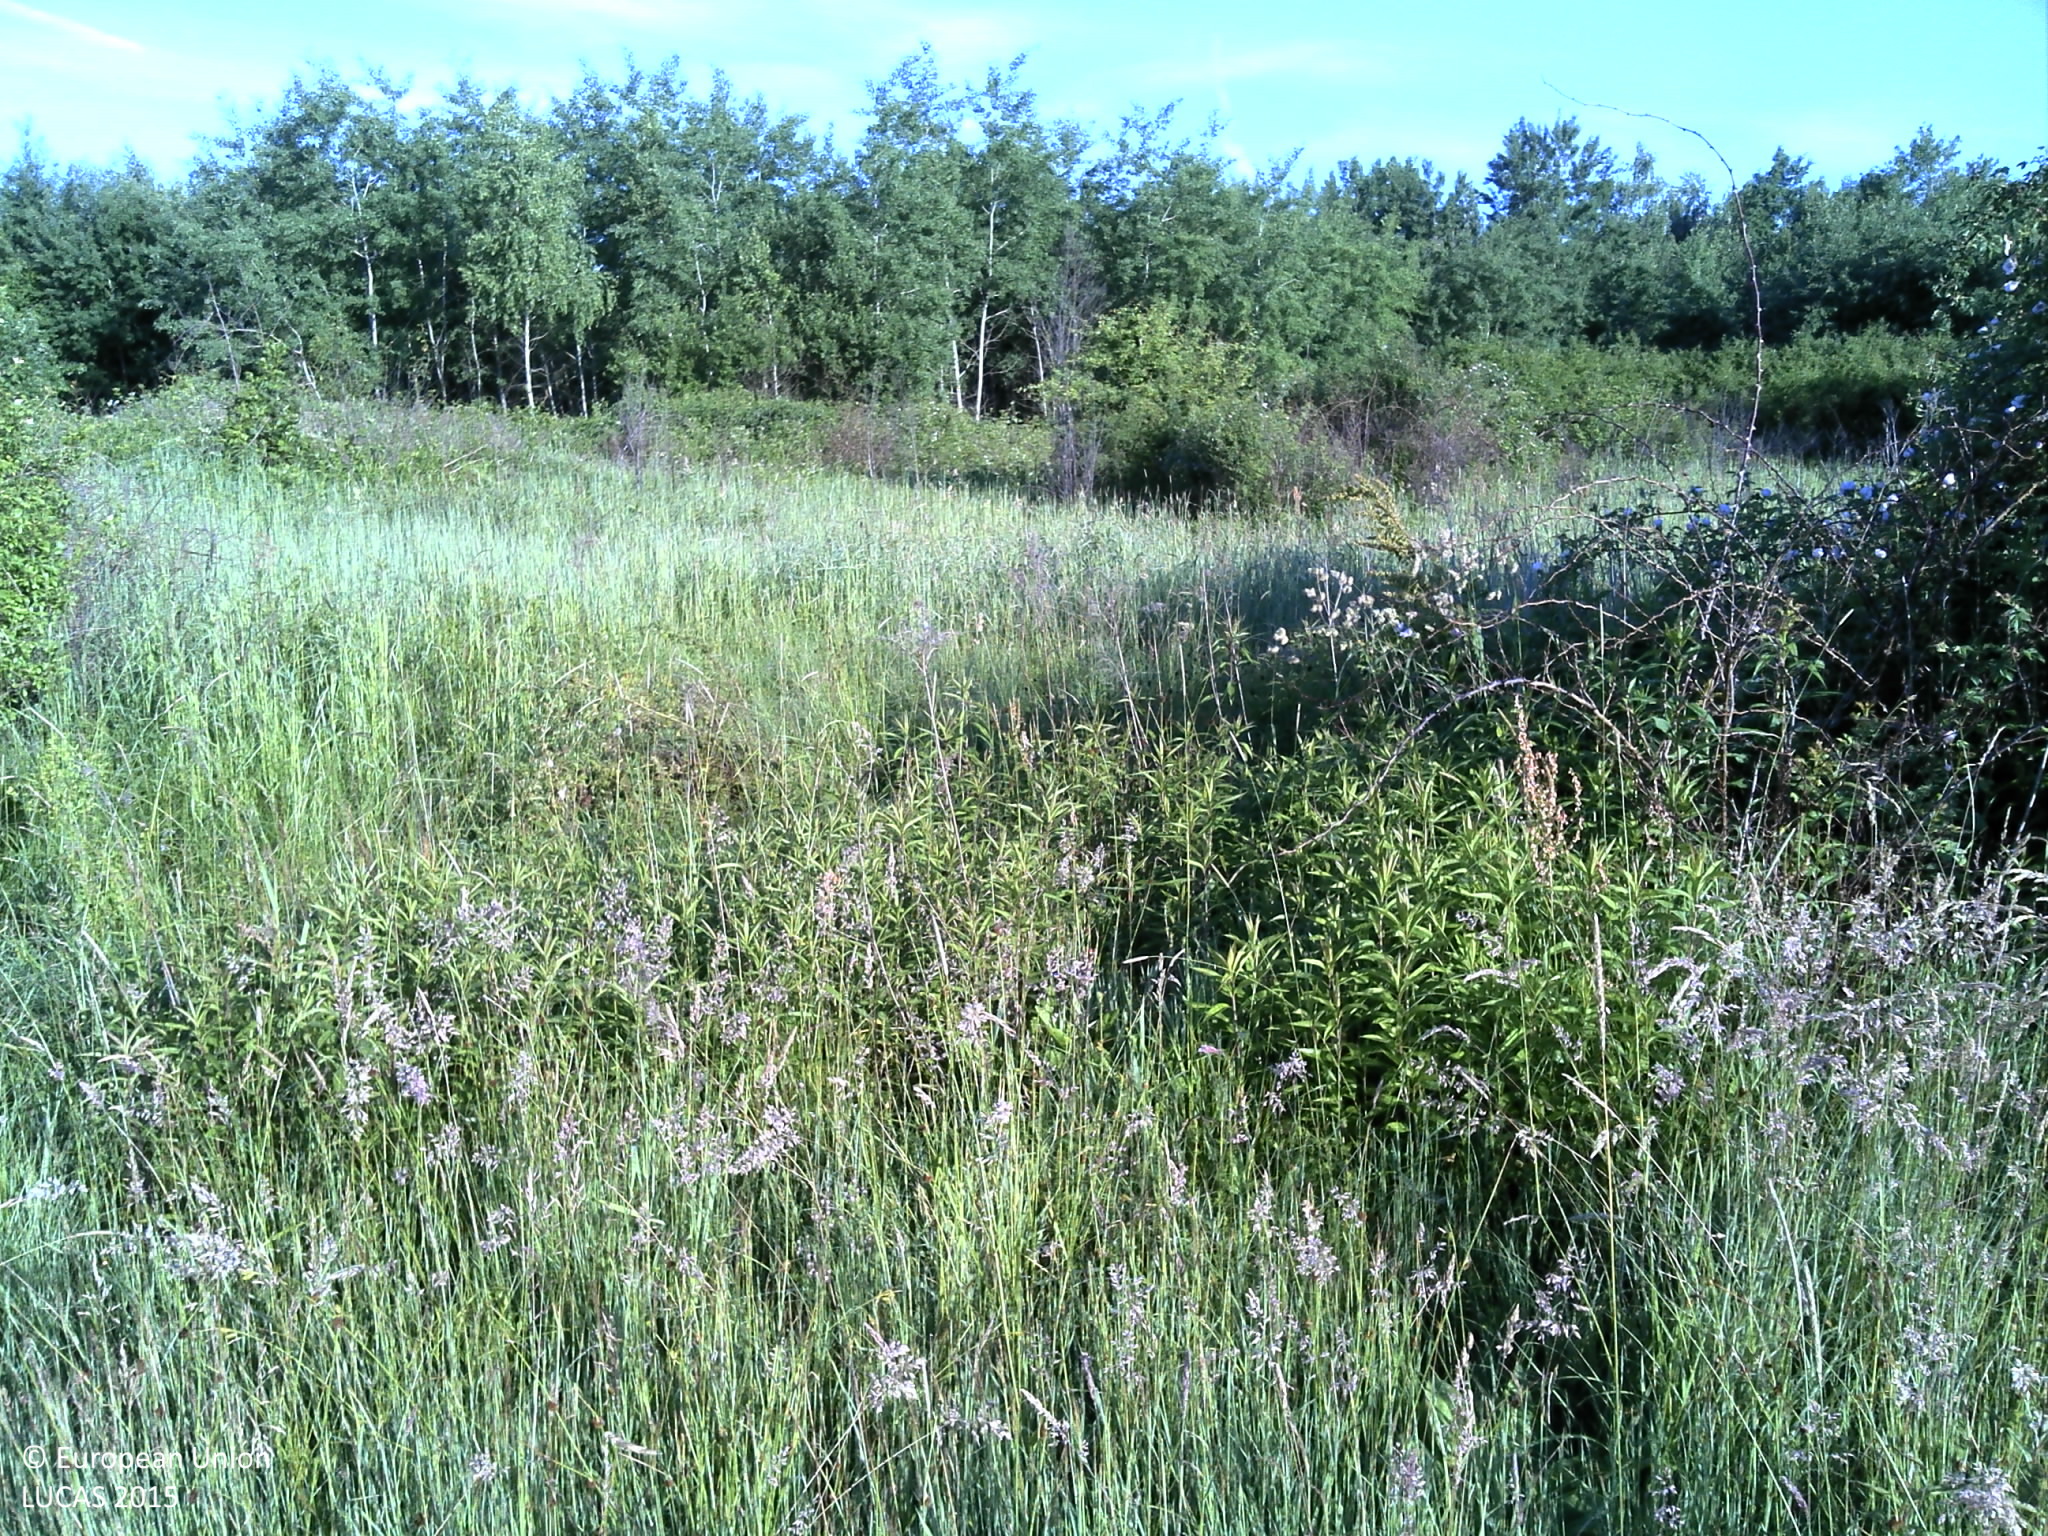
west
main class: Grassland
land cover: Spontaneously vegetated surfaces
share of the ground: > 75 %
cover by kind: herbaceous plants 100 %
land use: Abandoned areas
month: May
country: HR
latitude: 45.5477
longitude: 17.9578
